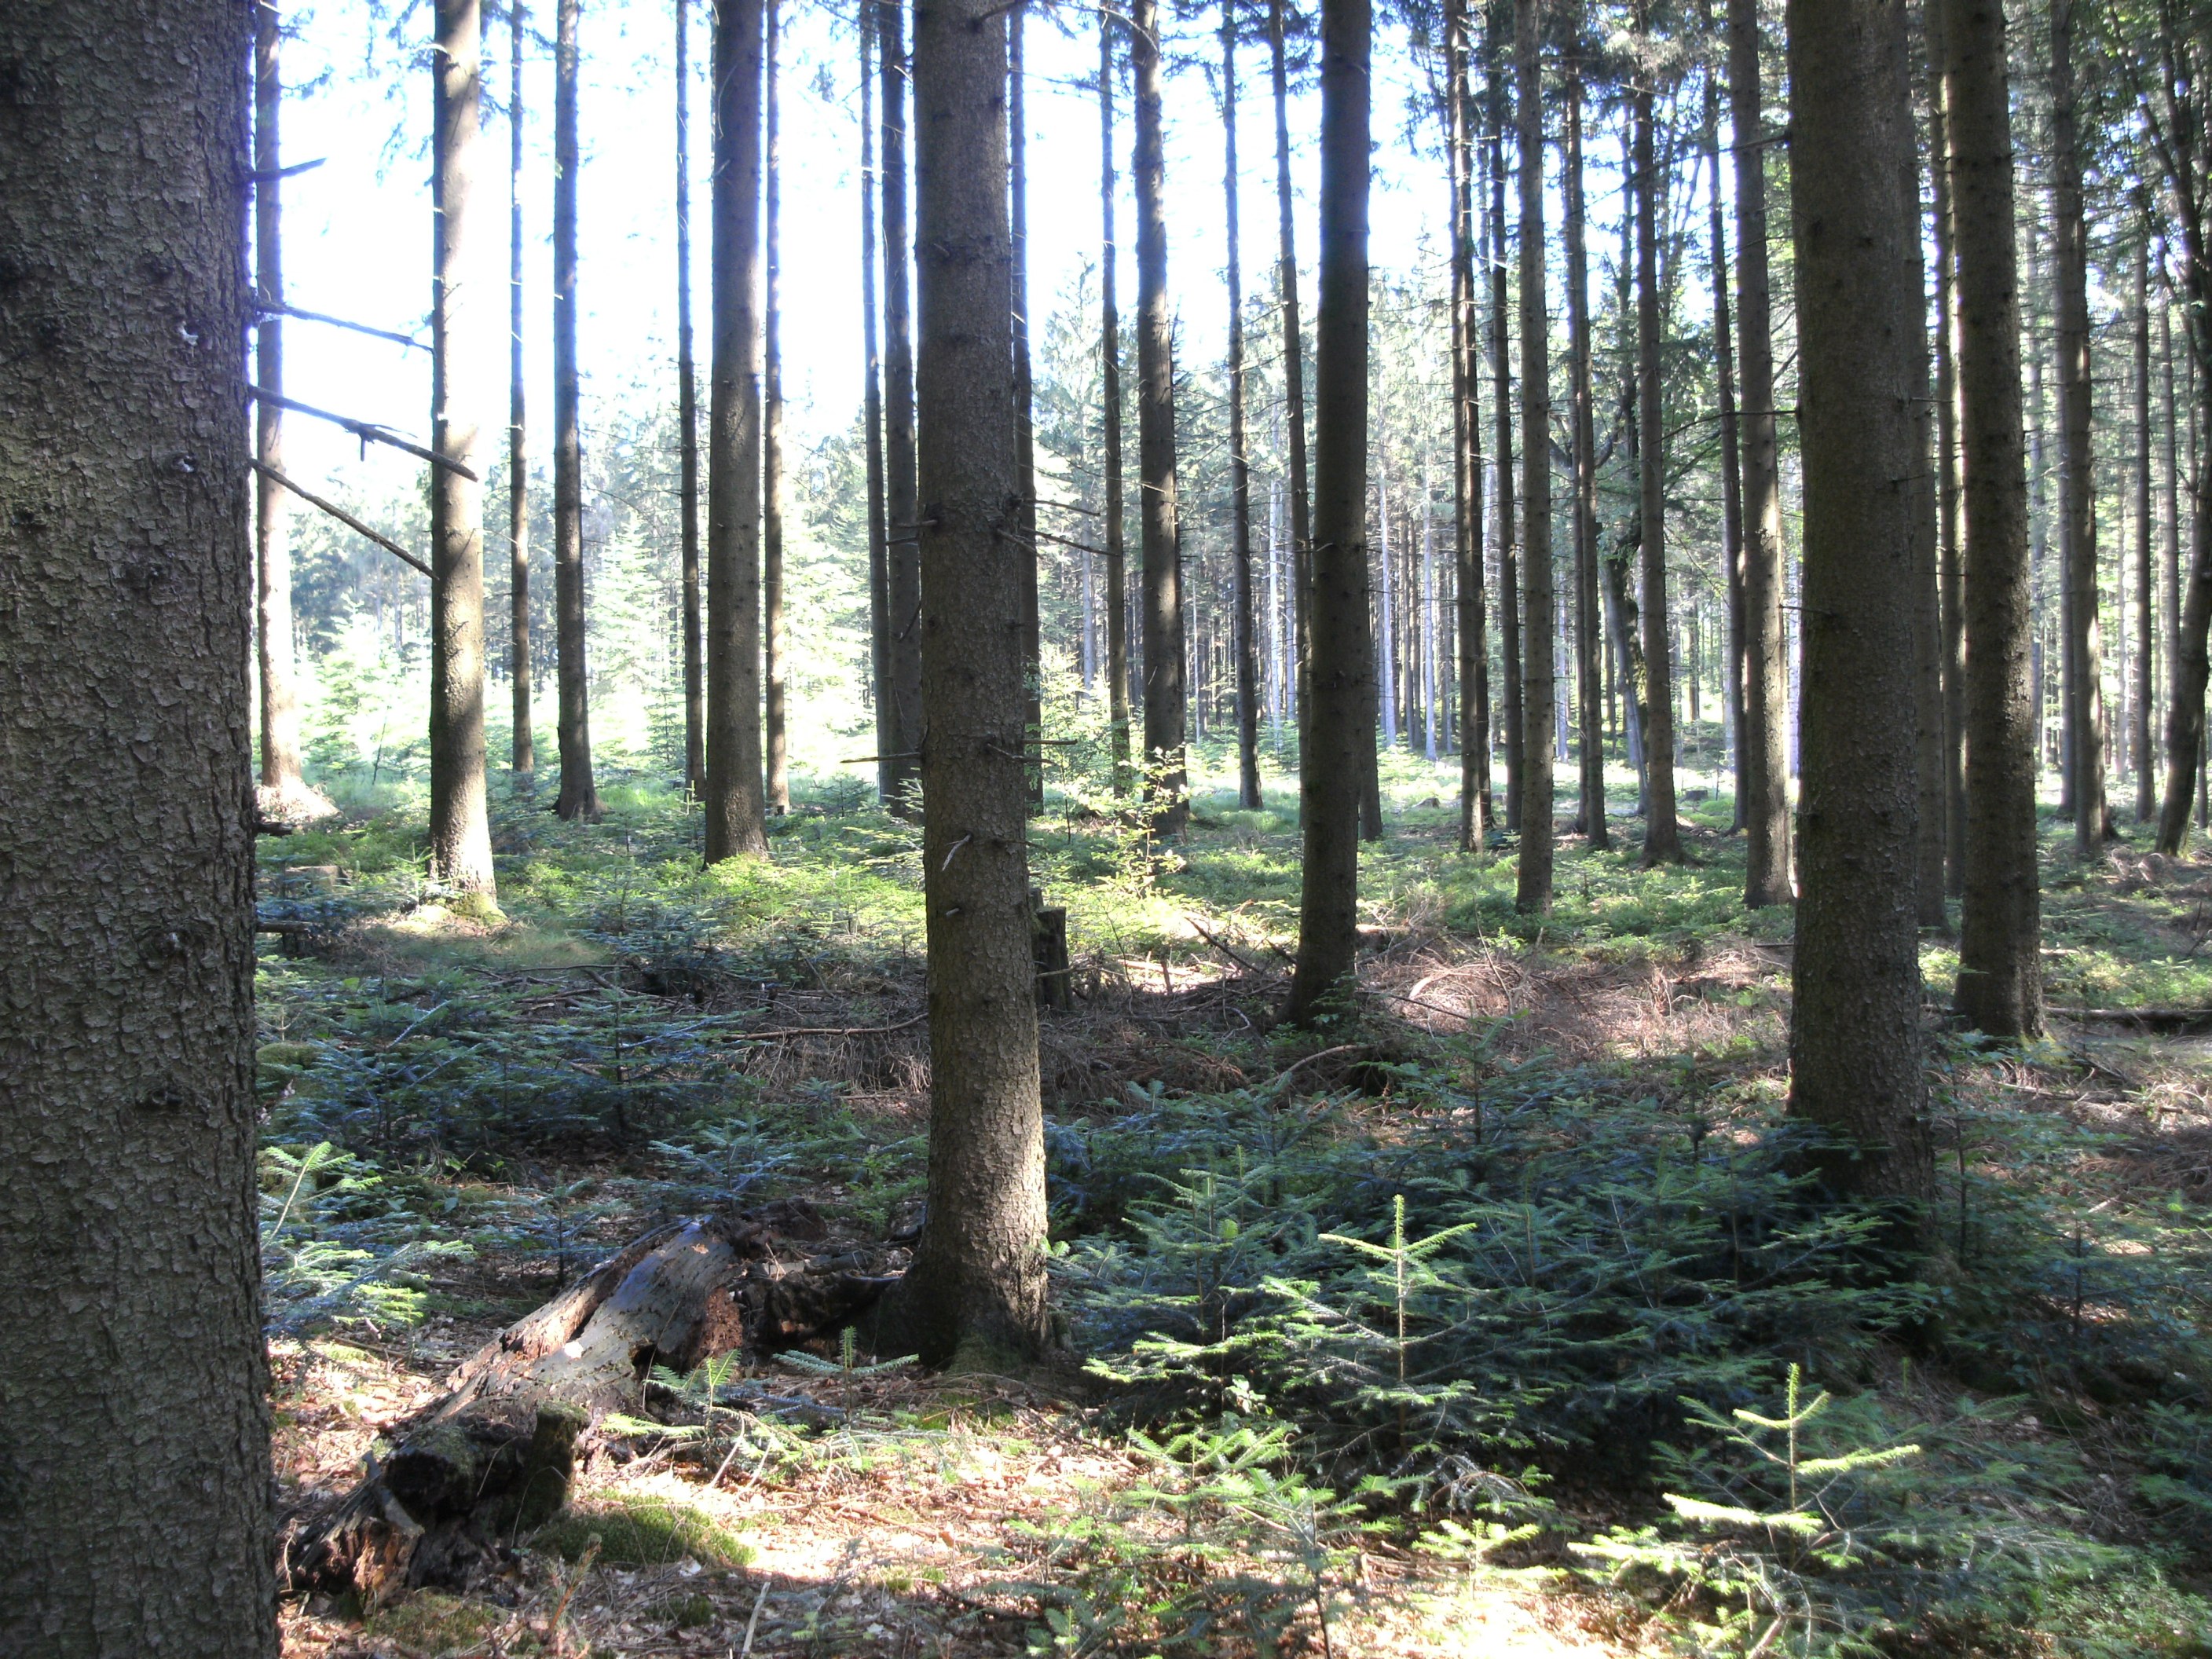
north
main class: Woodland
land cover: Spruce dominated coniferous woodland
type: hemiboreal forest and nemoral coniferous forest and mixed broadleaved-coniferous forest
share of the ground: > 75 %
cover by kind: coniferous forest trees 80 %, broadleaved forest trees 10 %, unconsolidated bare surface 10 %
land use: Forestry
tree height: > 5 m
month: June
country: AT
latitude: 48.0812
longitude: 13.3952
